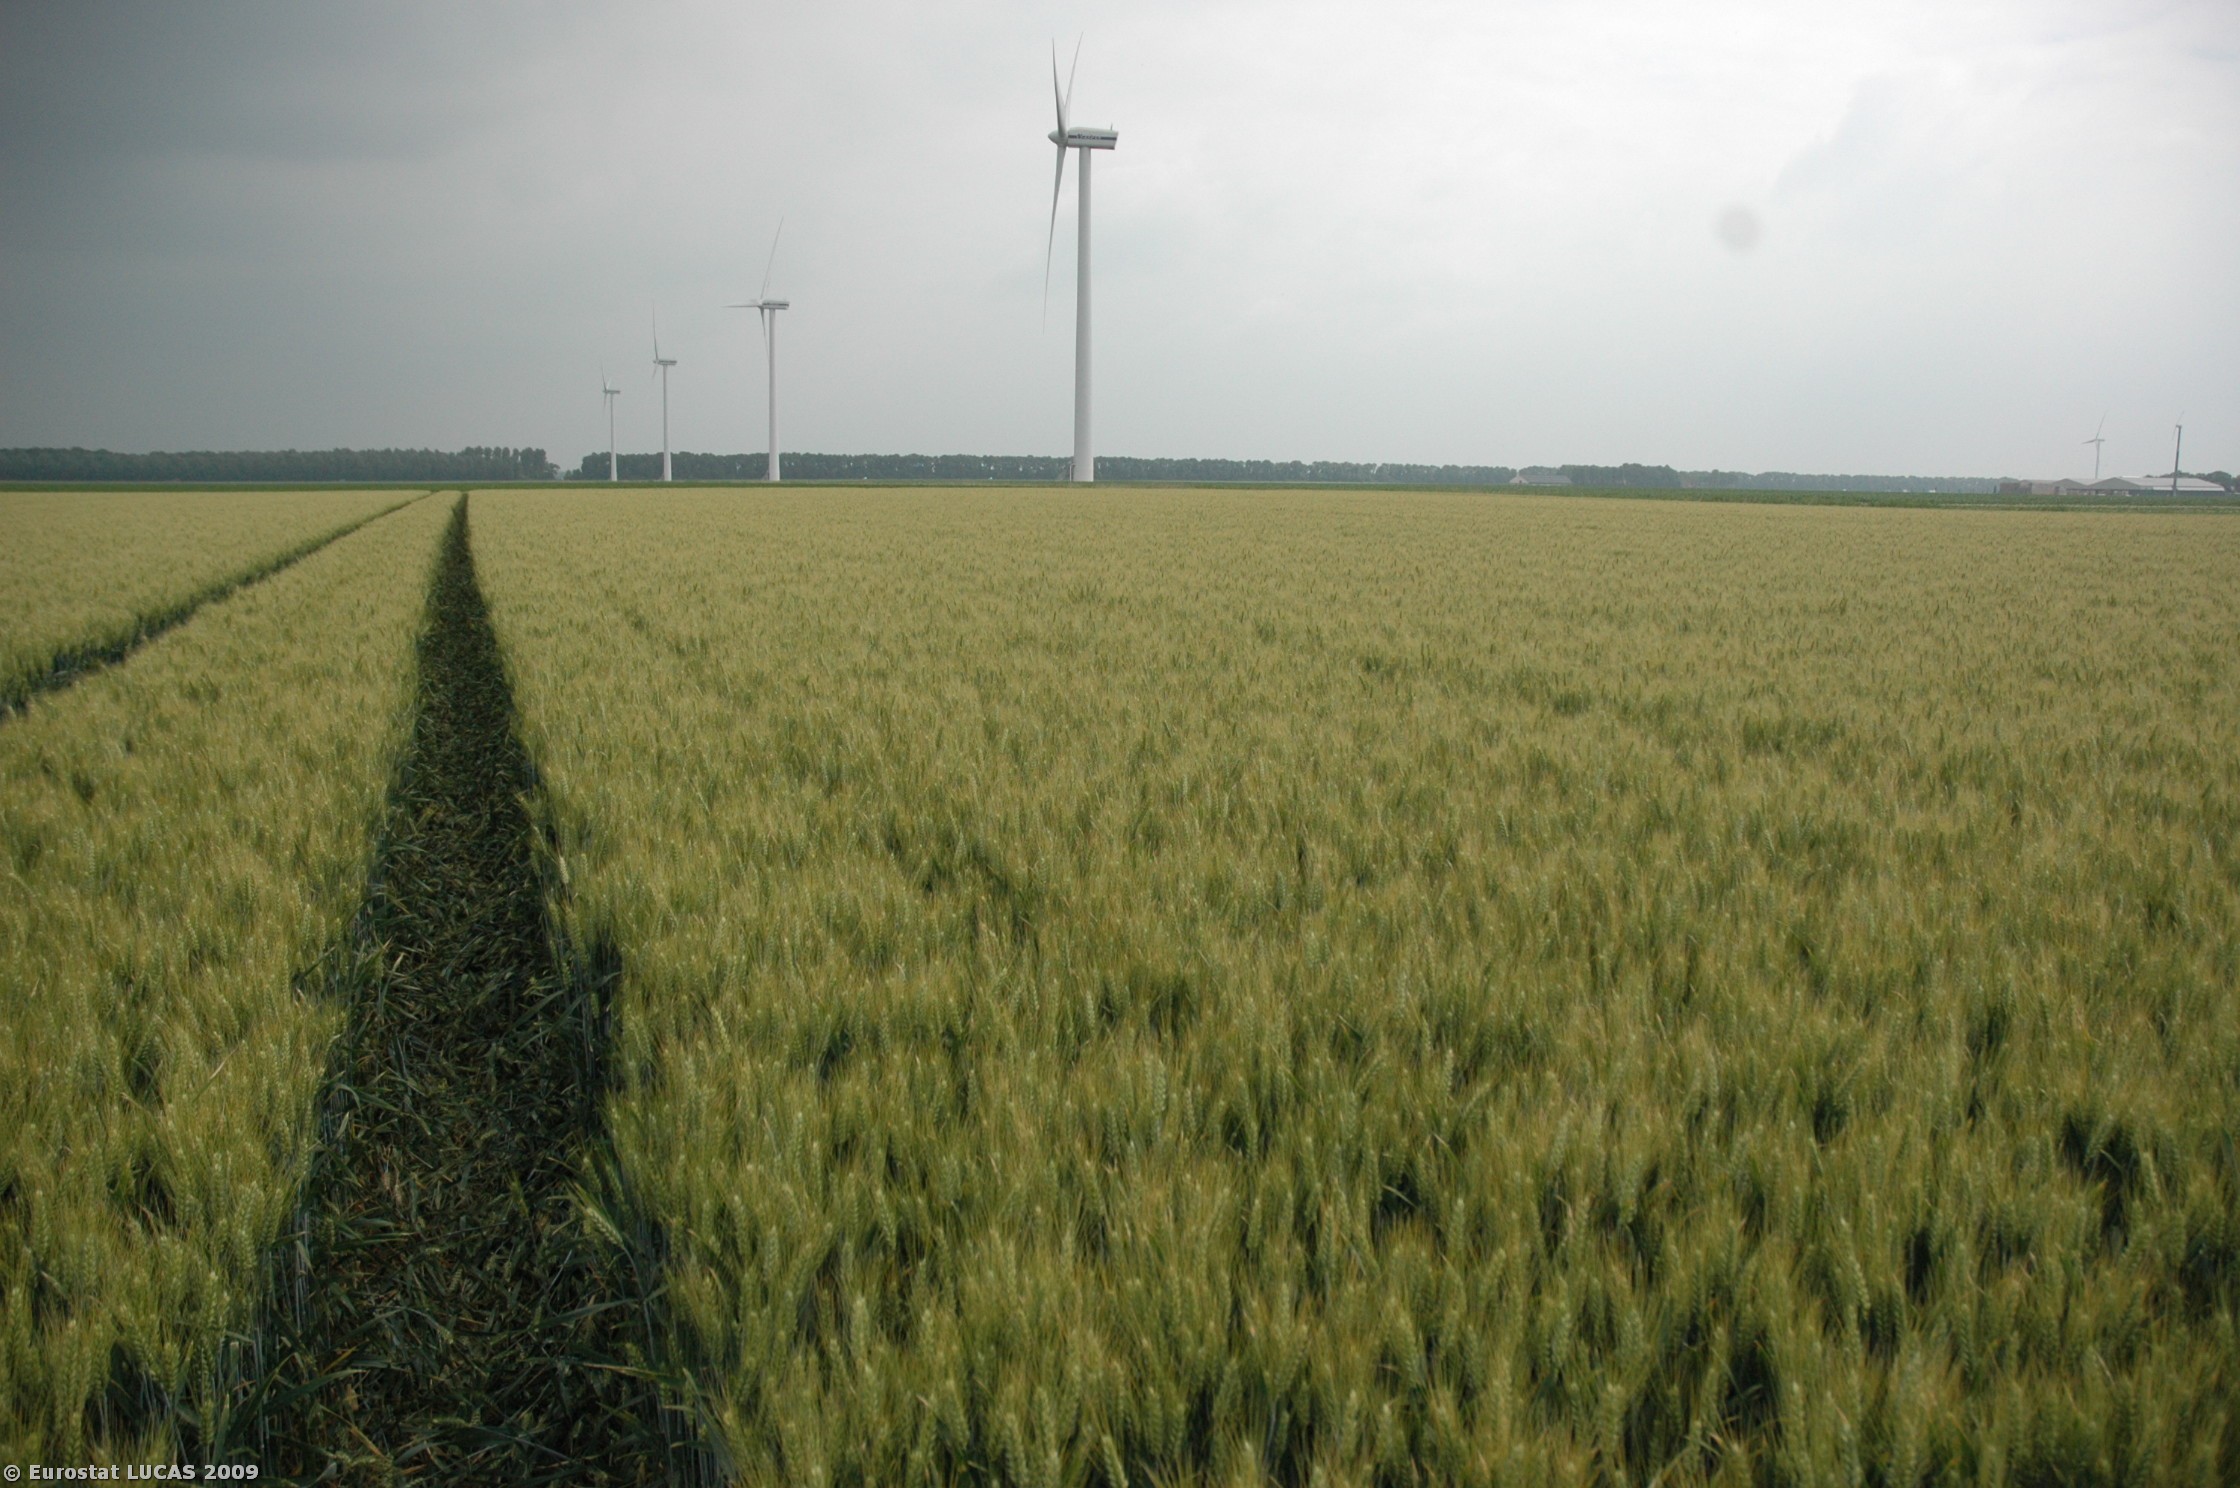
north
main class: Cropland
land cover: Common wheat
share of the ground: > 75 %
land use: Agriculture (excluding fallow land and kitchen gardens)
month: June
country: NL
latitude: 52.4601
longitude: 5.6570
